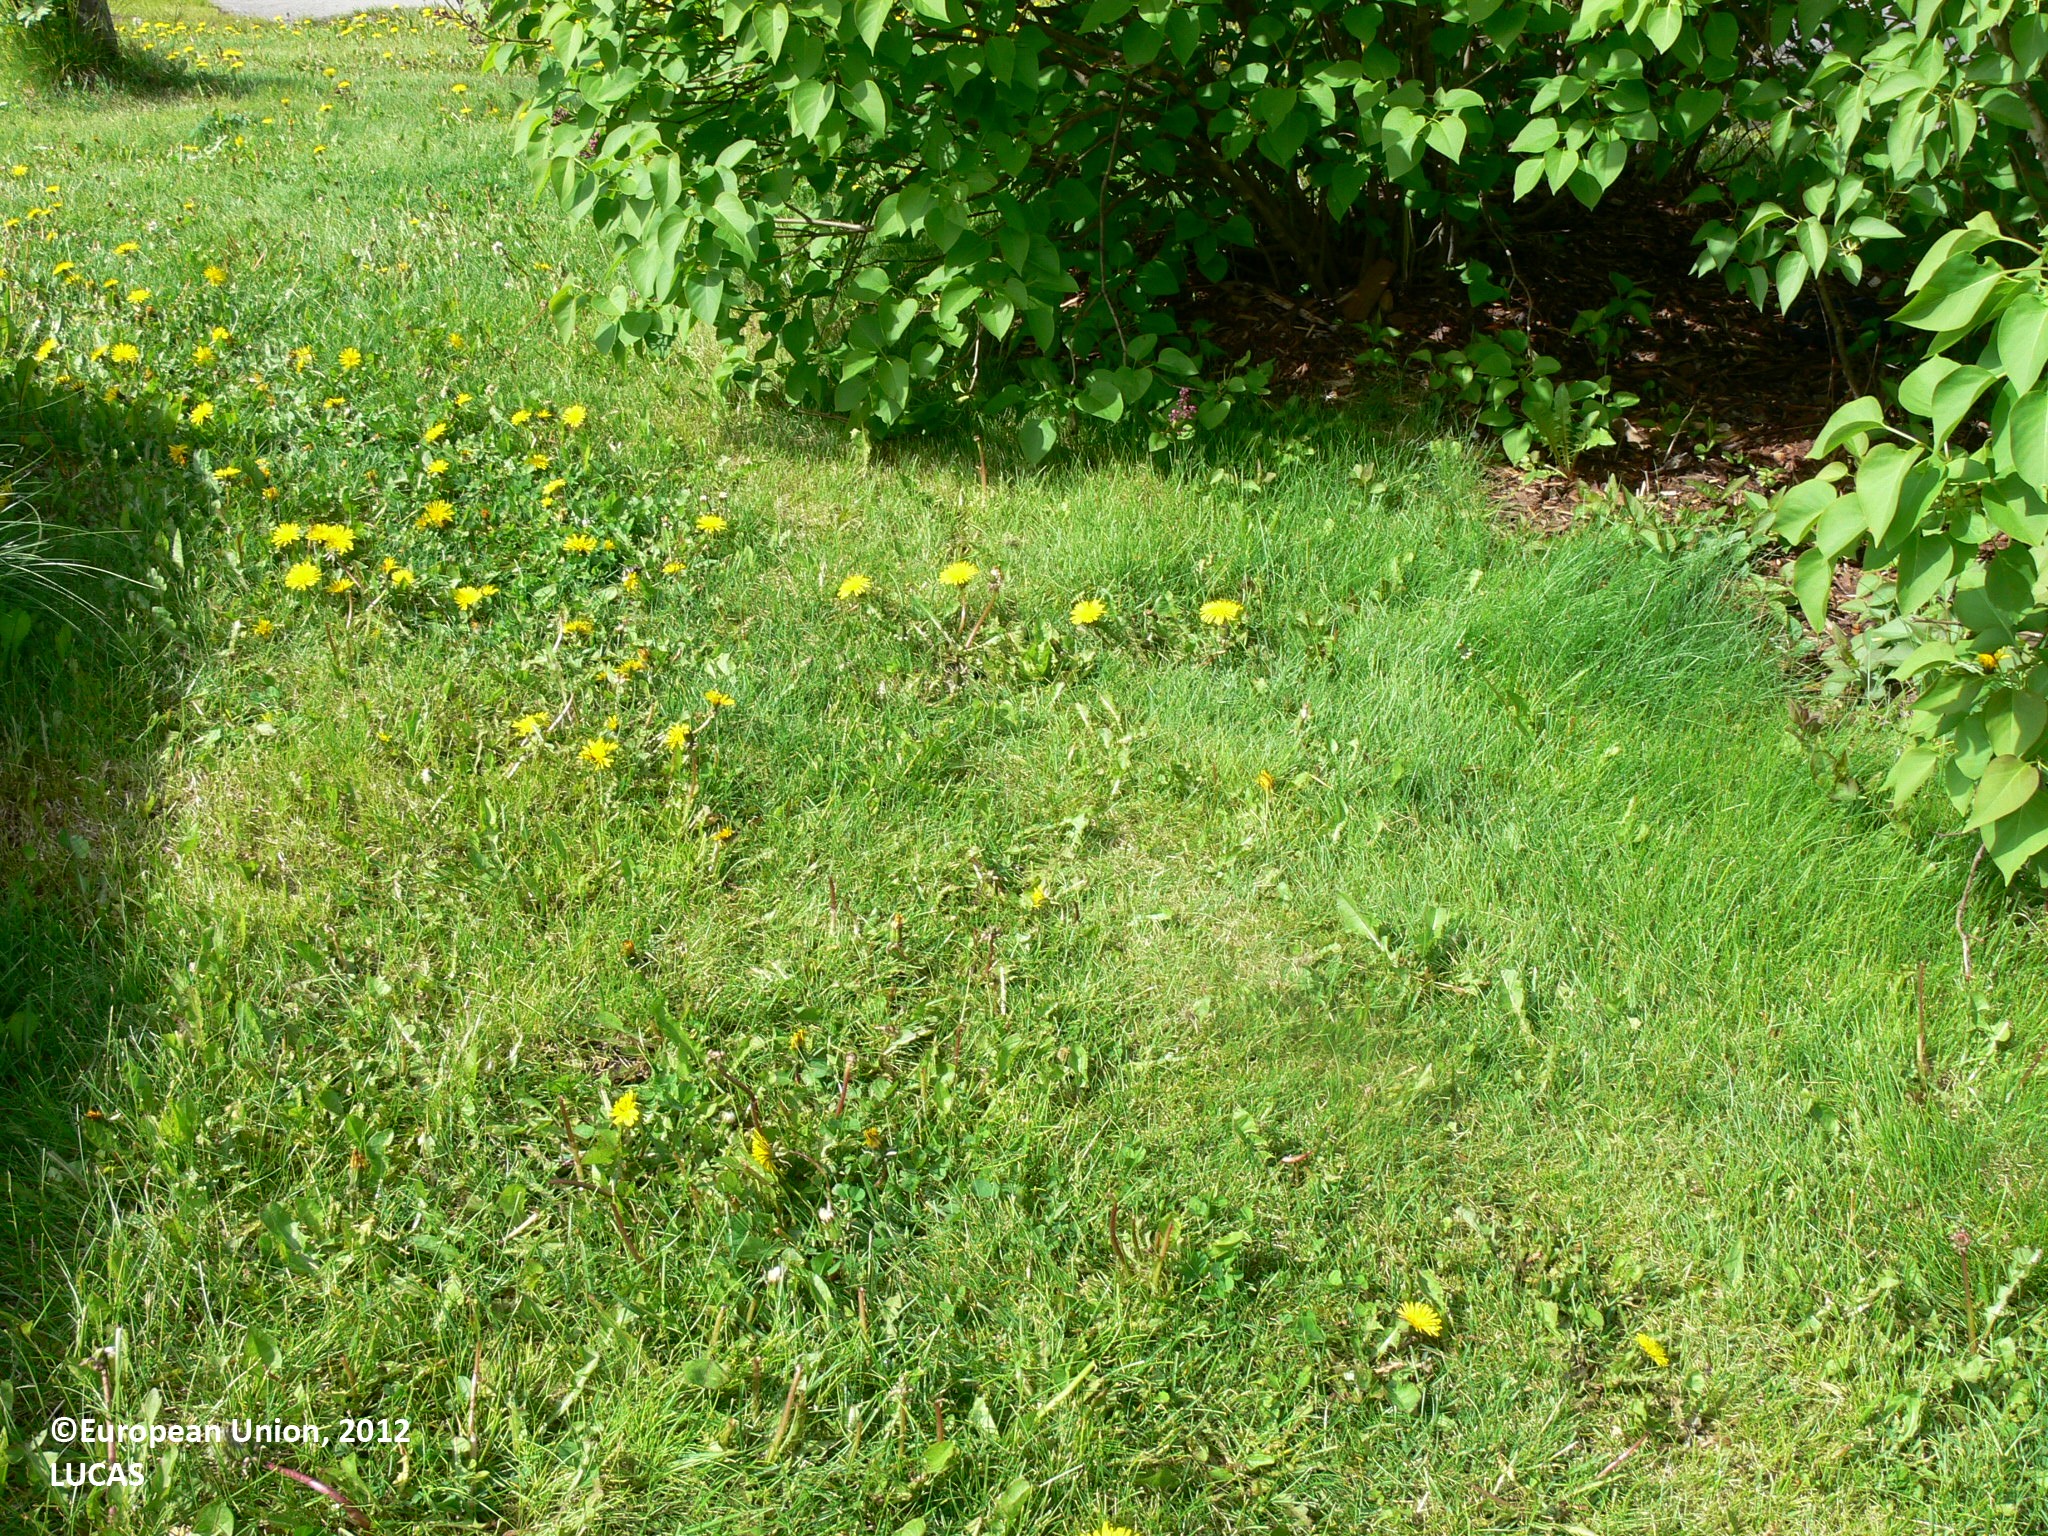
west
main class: Grassland
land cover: Grassland with sparse tree/shrub cover
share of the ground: 50 - 75 %
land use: Residential
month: June
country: FI
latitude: 62.5996
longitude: 29.8268
